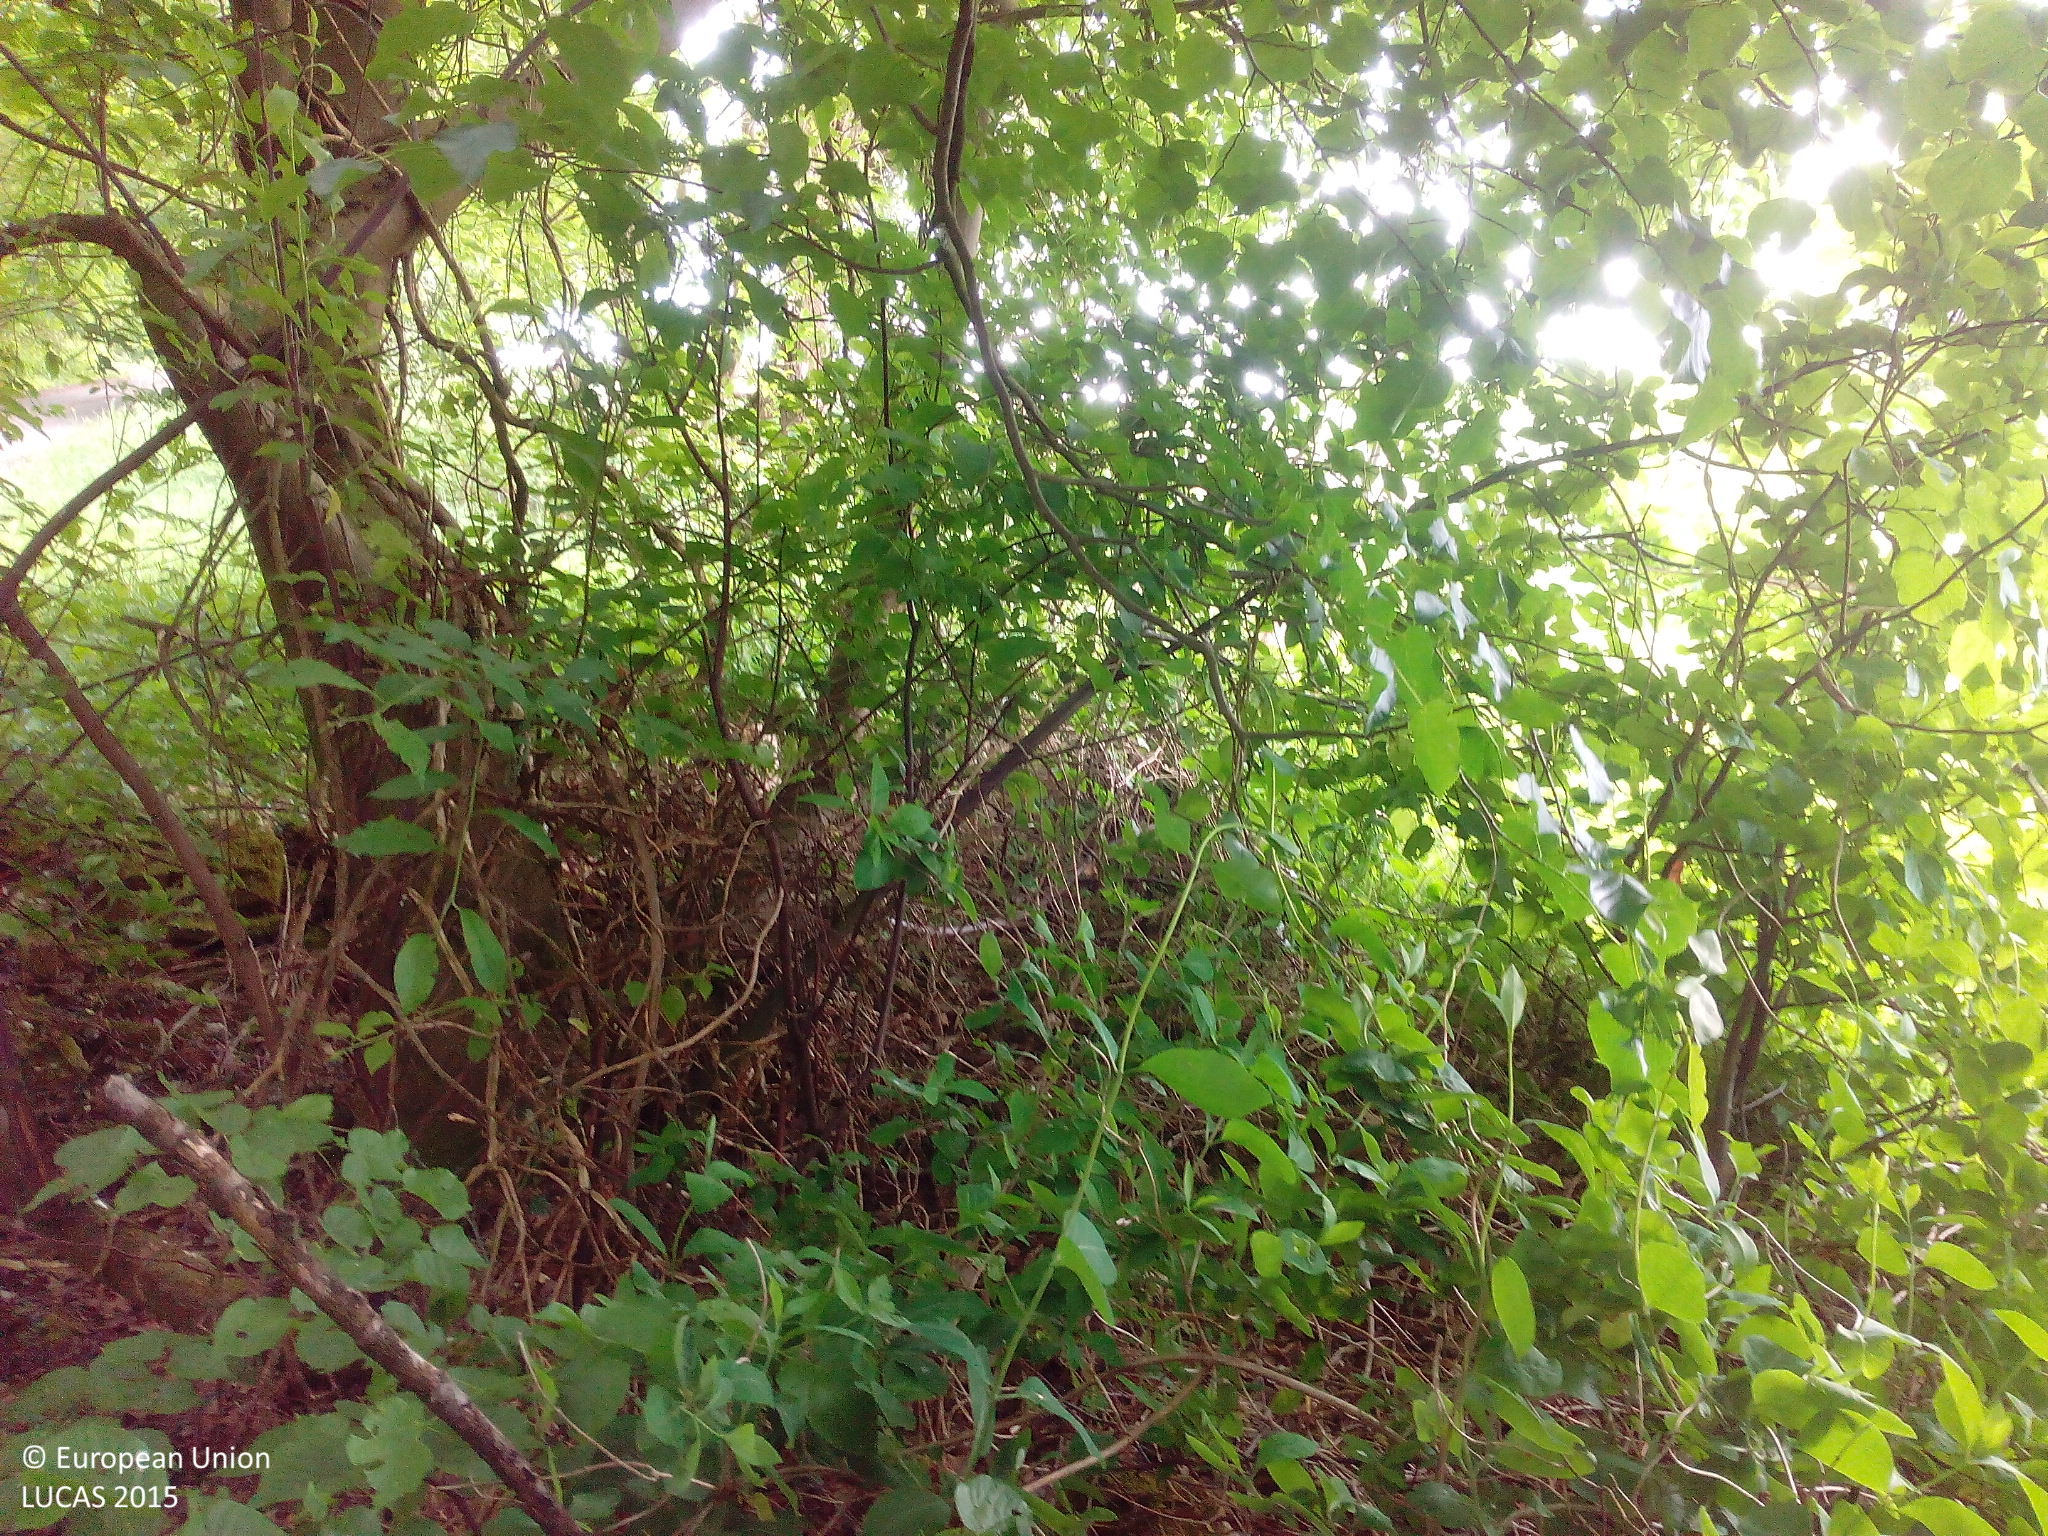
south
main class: Woodland
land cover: Broadleaved woodland
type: beech forest
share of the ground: > 75 %
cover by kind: broadleaved forest trees 100 %
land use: Forestry
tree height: > 5 m
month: May
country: DE
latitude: 51.2623
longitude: 9.6132
